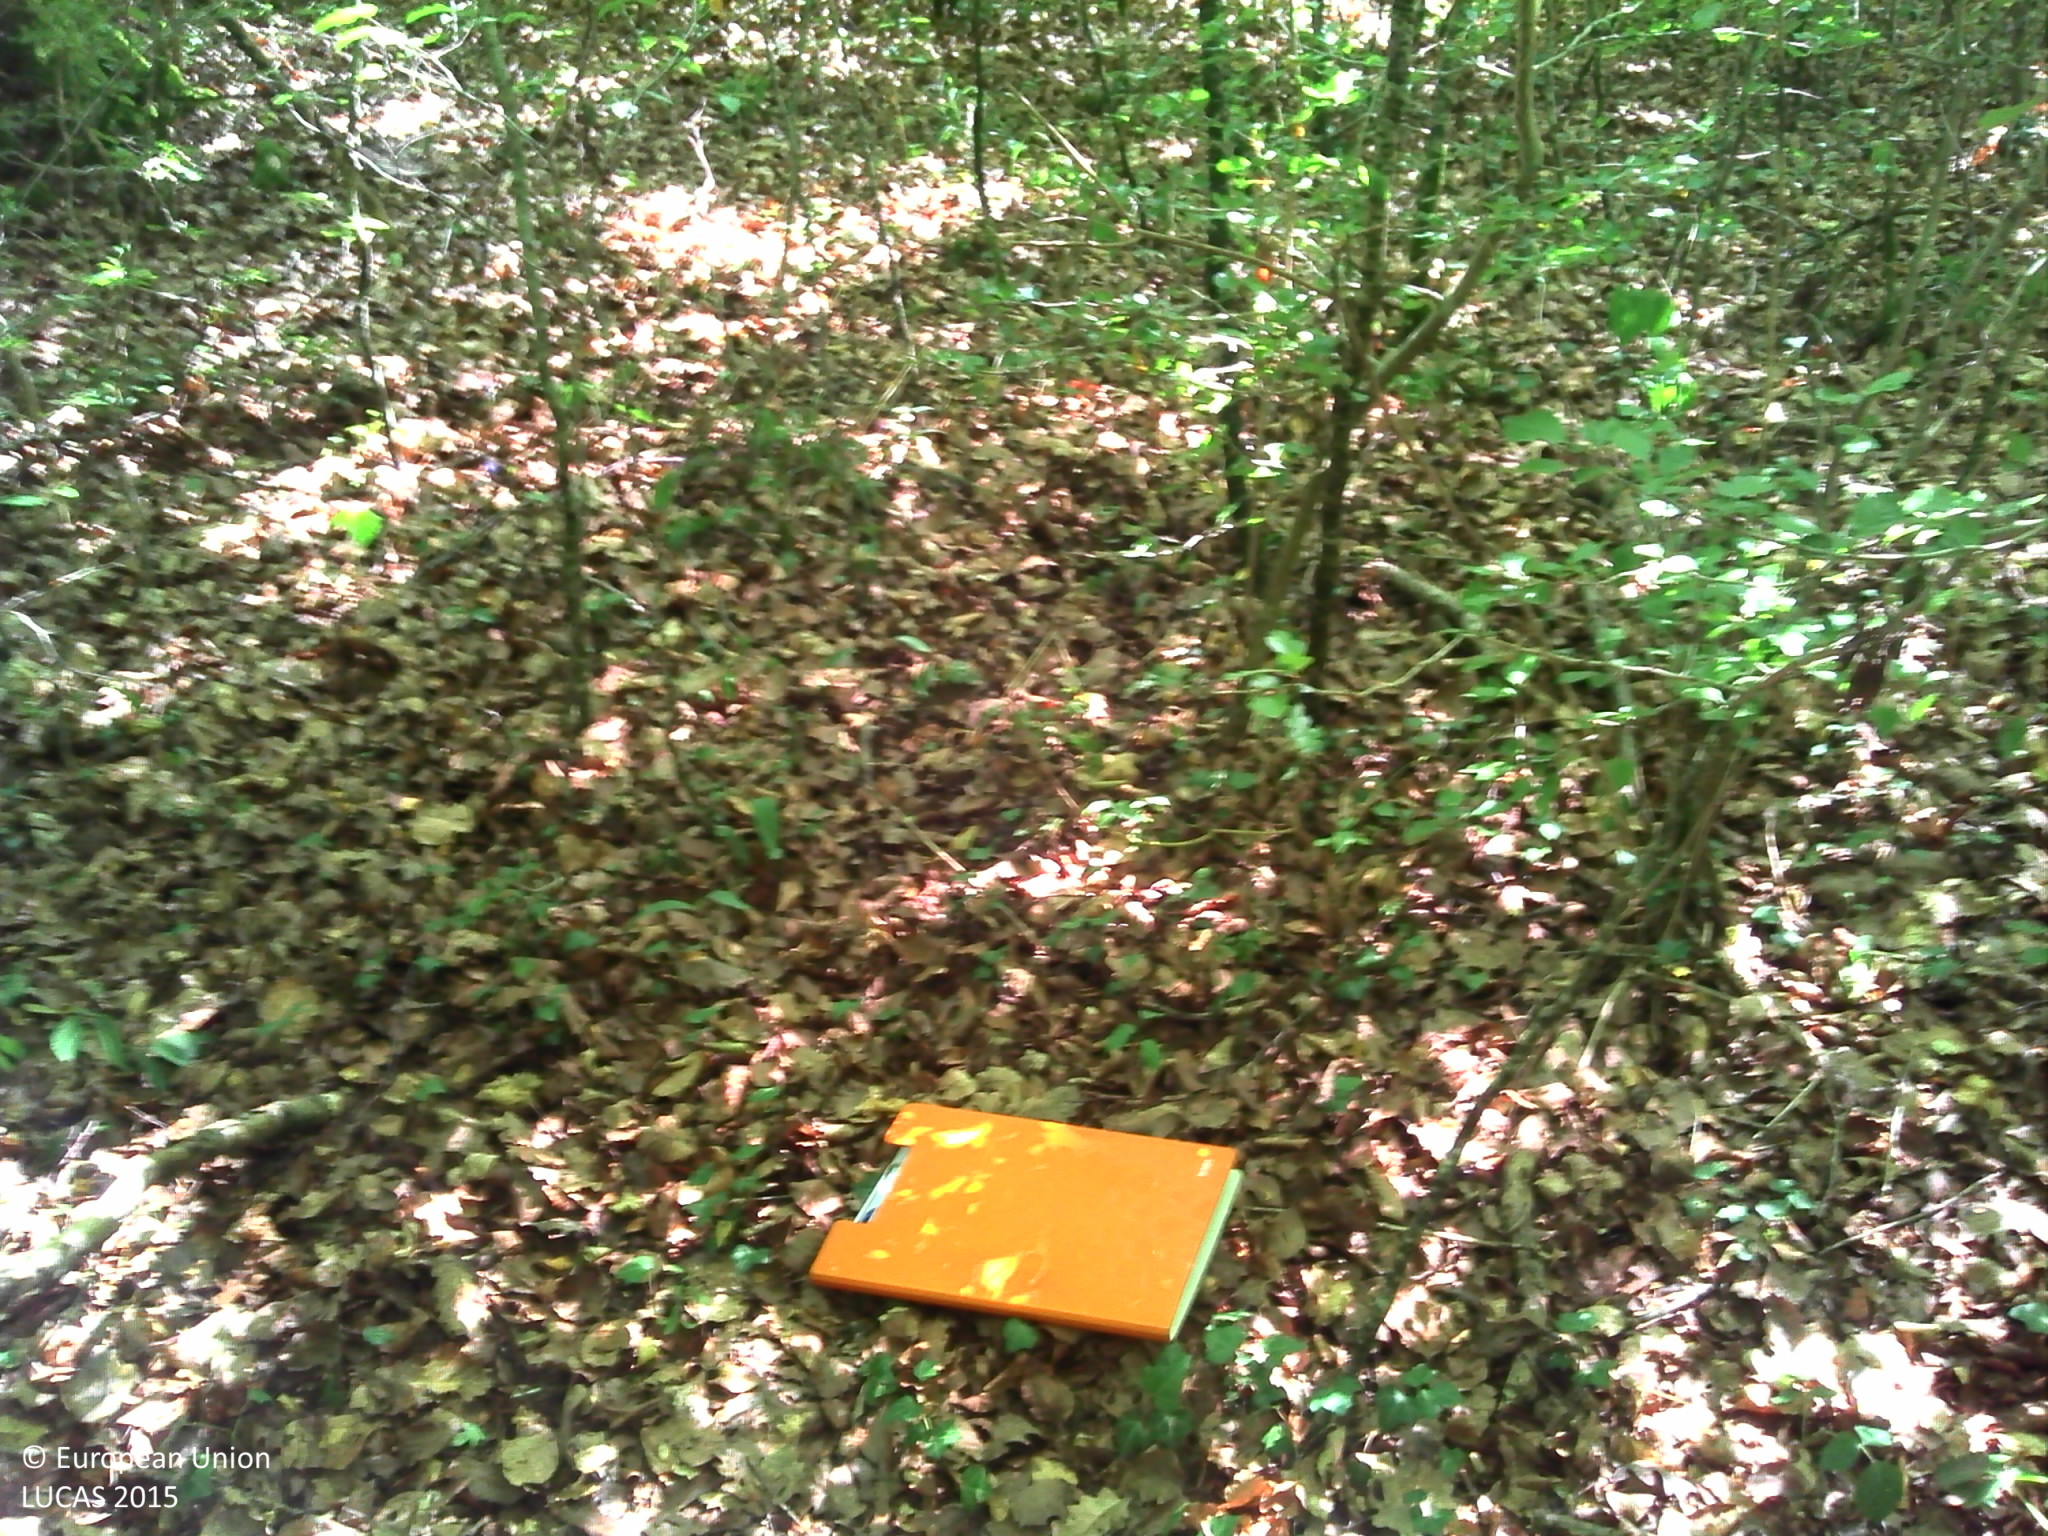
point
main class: Woodland
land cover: Broadleaved woodland
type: acidophilous oak and oak-birch forest
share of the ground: > 75 %
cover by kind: broadleaved forest trees 90 %, herbaceous plants 5 %, lichens and mosses 5 %
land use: Forestry
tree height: > 5 m
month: July
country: FR
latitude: 48.0254
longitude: 4.7288
